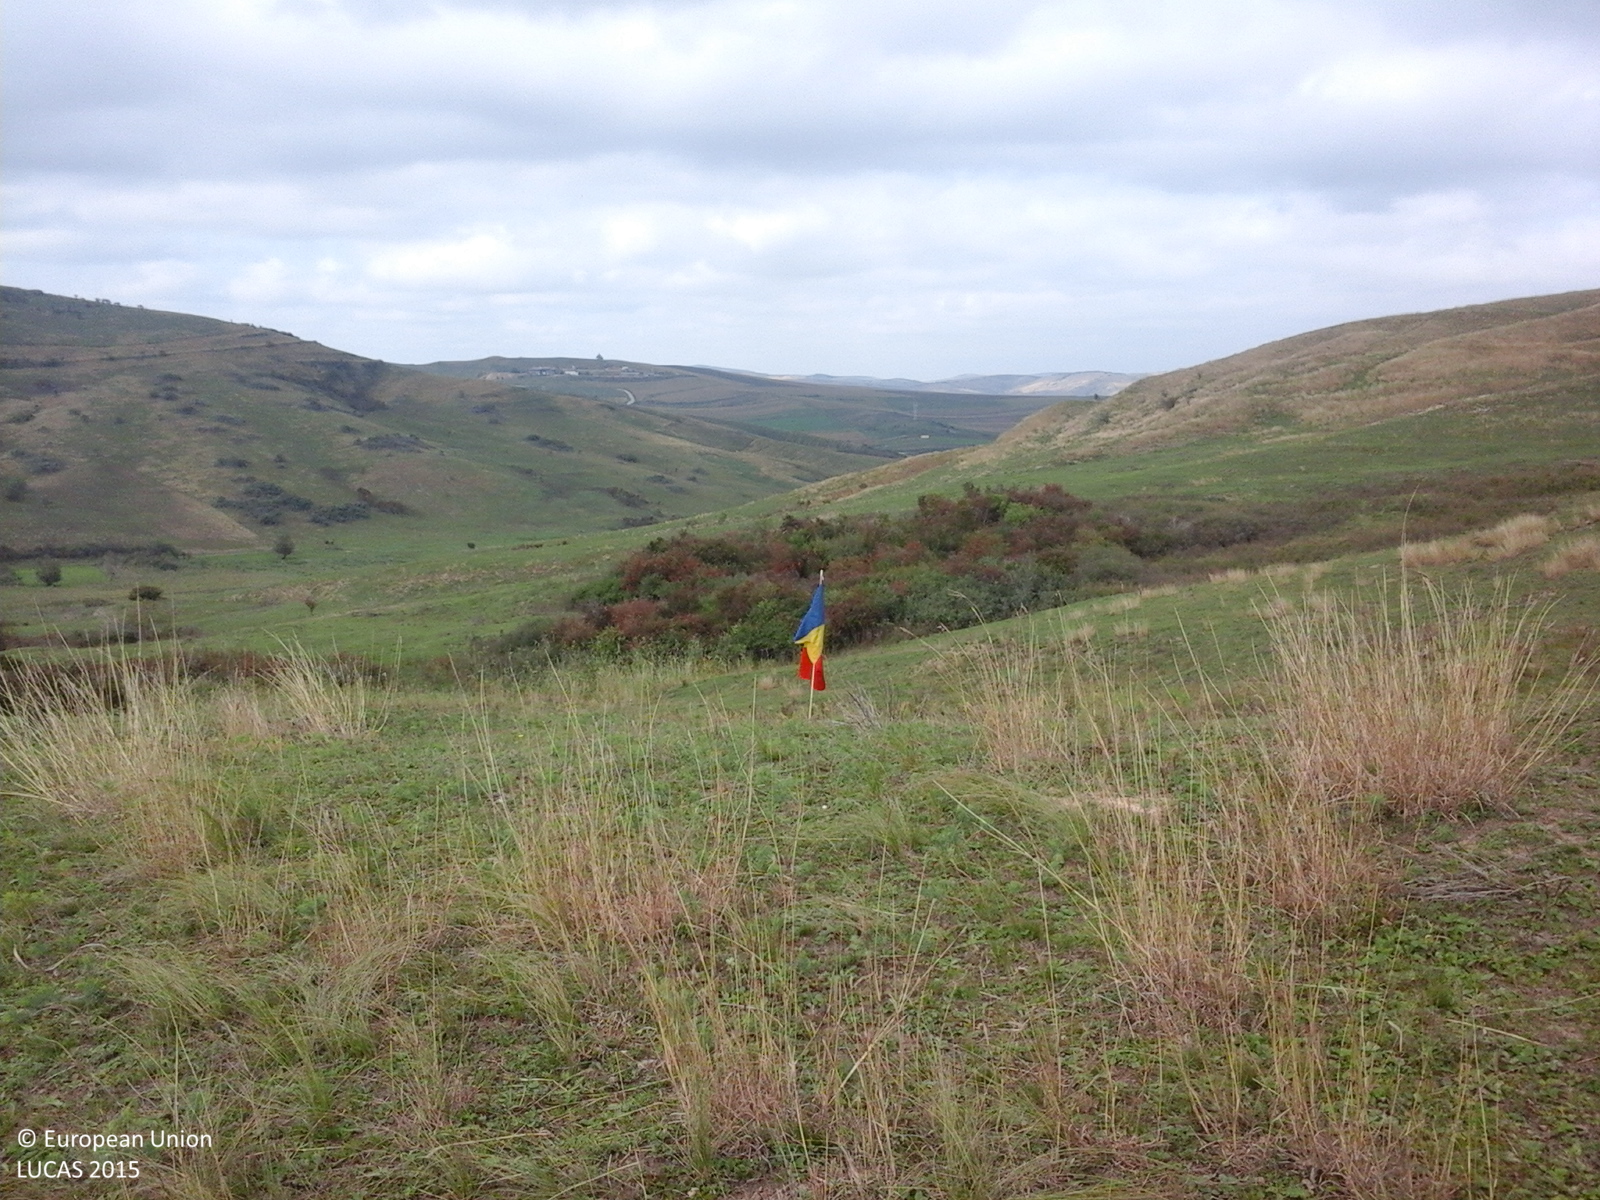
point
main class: Grassland
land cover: Grassland without tree/shrub cover
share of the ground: > 75 %
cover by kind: herbaceous plants 100 %
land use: Agriculture (excluding fallow land and kitchen gardens)
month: October
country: RO
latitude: 46.4245
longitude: 24.0393
